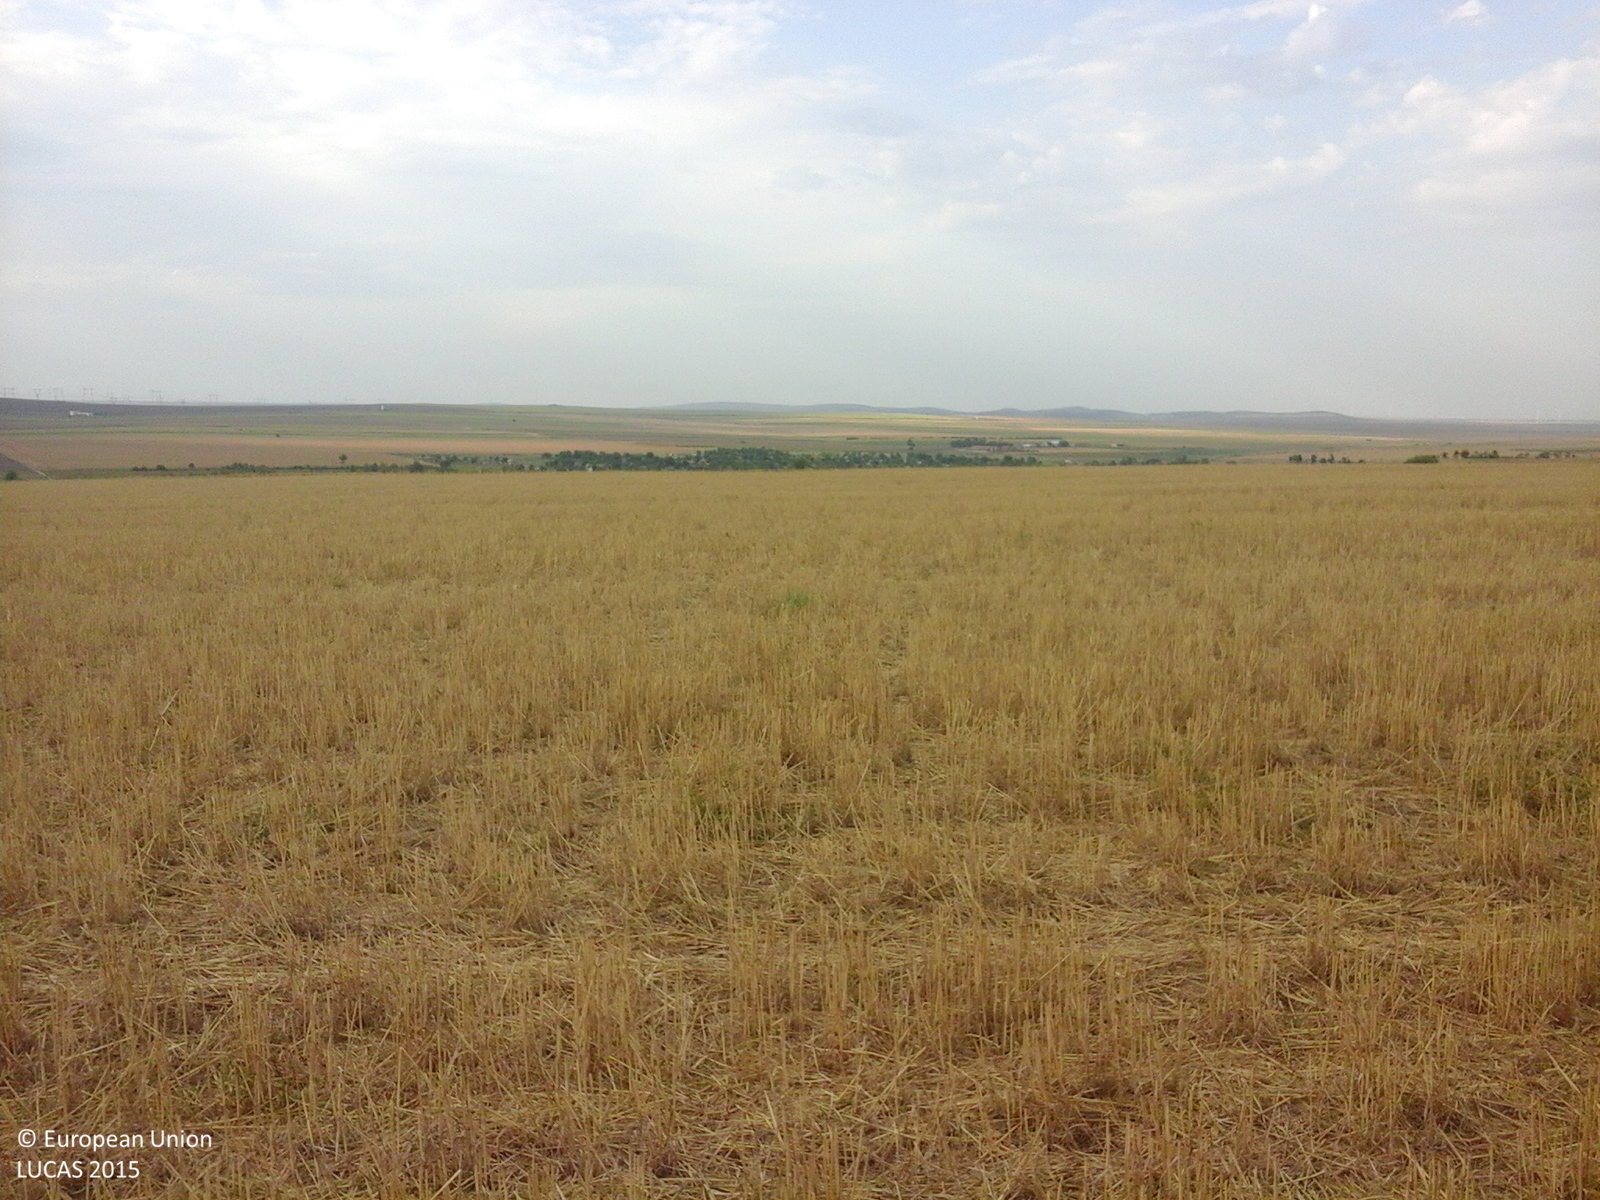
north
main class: Cropland
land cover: Common wheat
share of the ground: > 75 %
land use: Agriculture (excluding fallow land and kitchen gardens)
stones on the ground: < 10 %
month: August
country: RO
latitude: 44.3894
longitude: 28.1760
